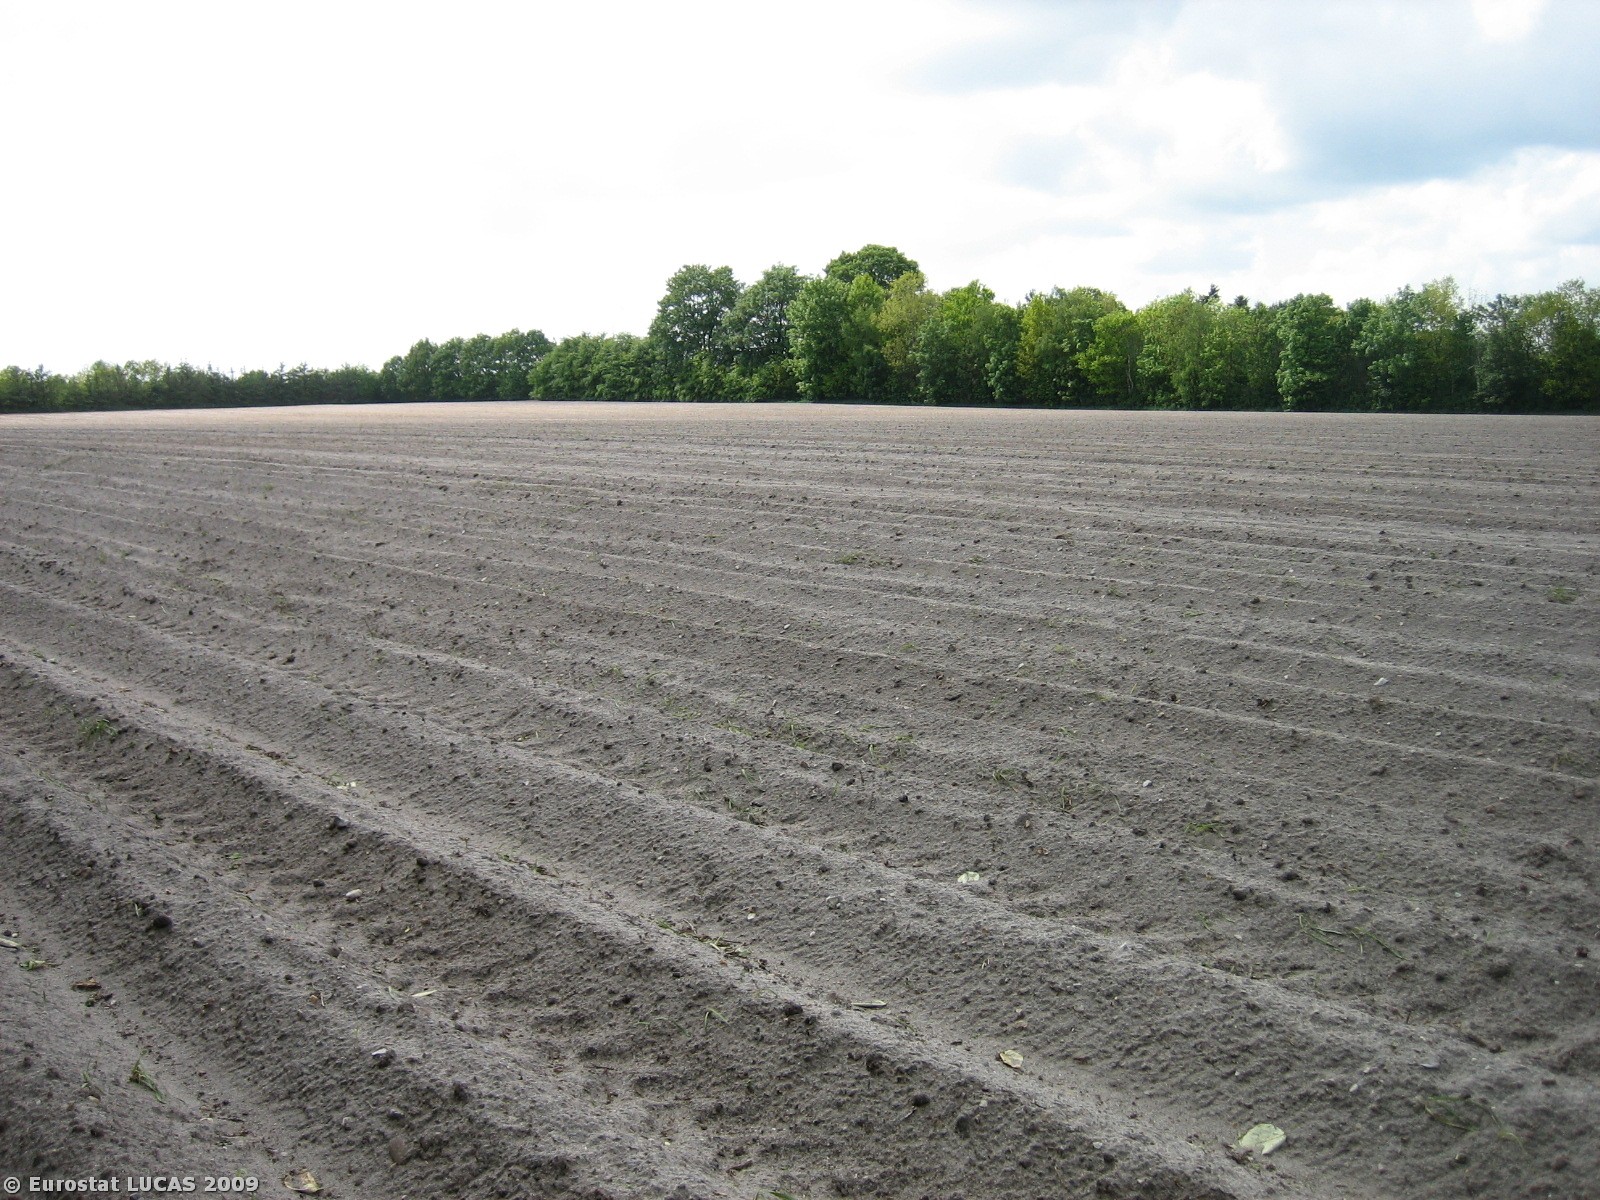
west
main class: Woodland
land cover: Broadleaved woodland
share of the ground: > 75 %
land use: Unused
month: May
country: DK
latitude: 56.2911
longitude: 8.9188
